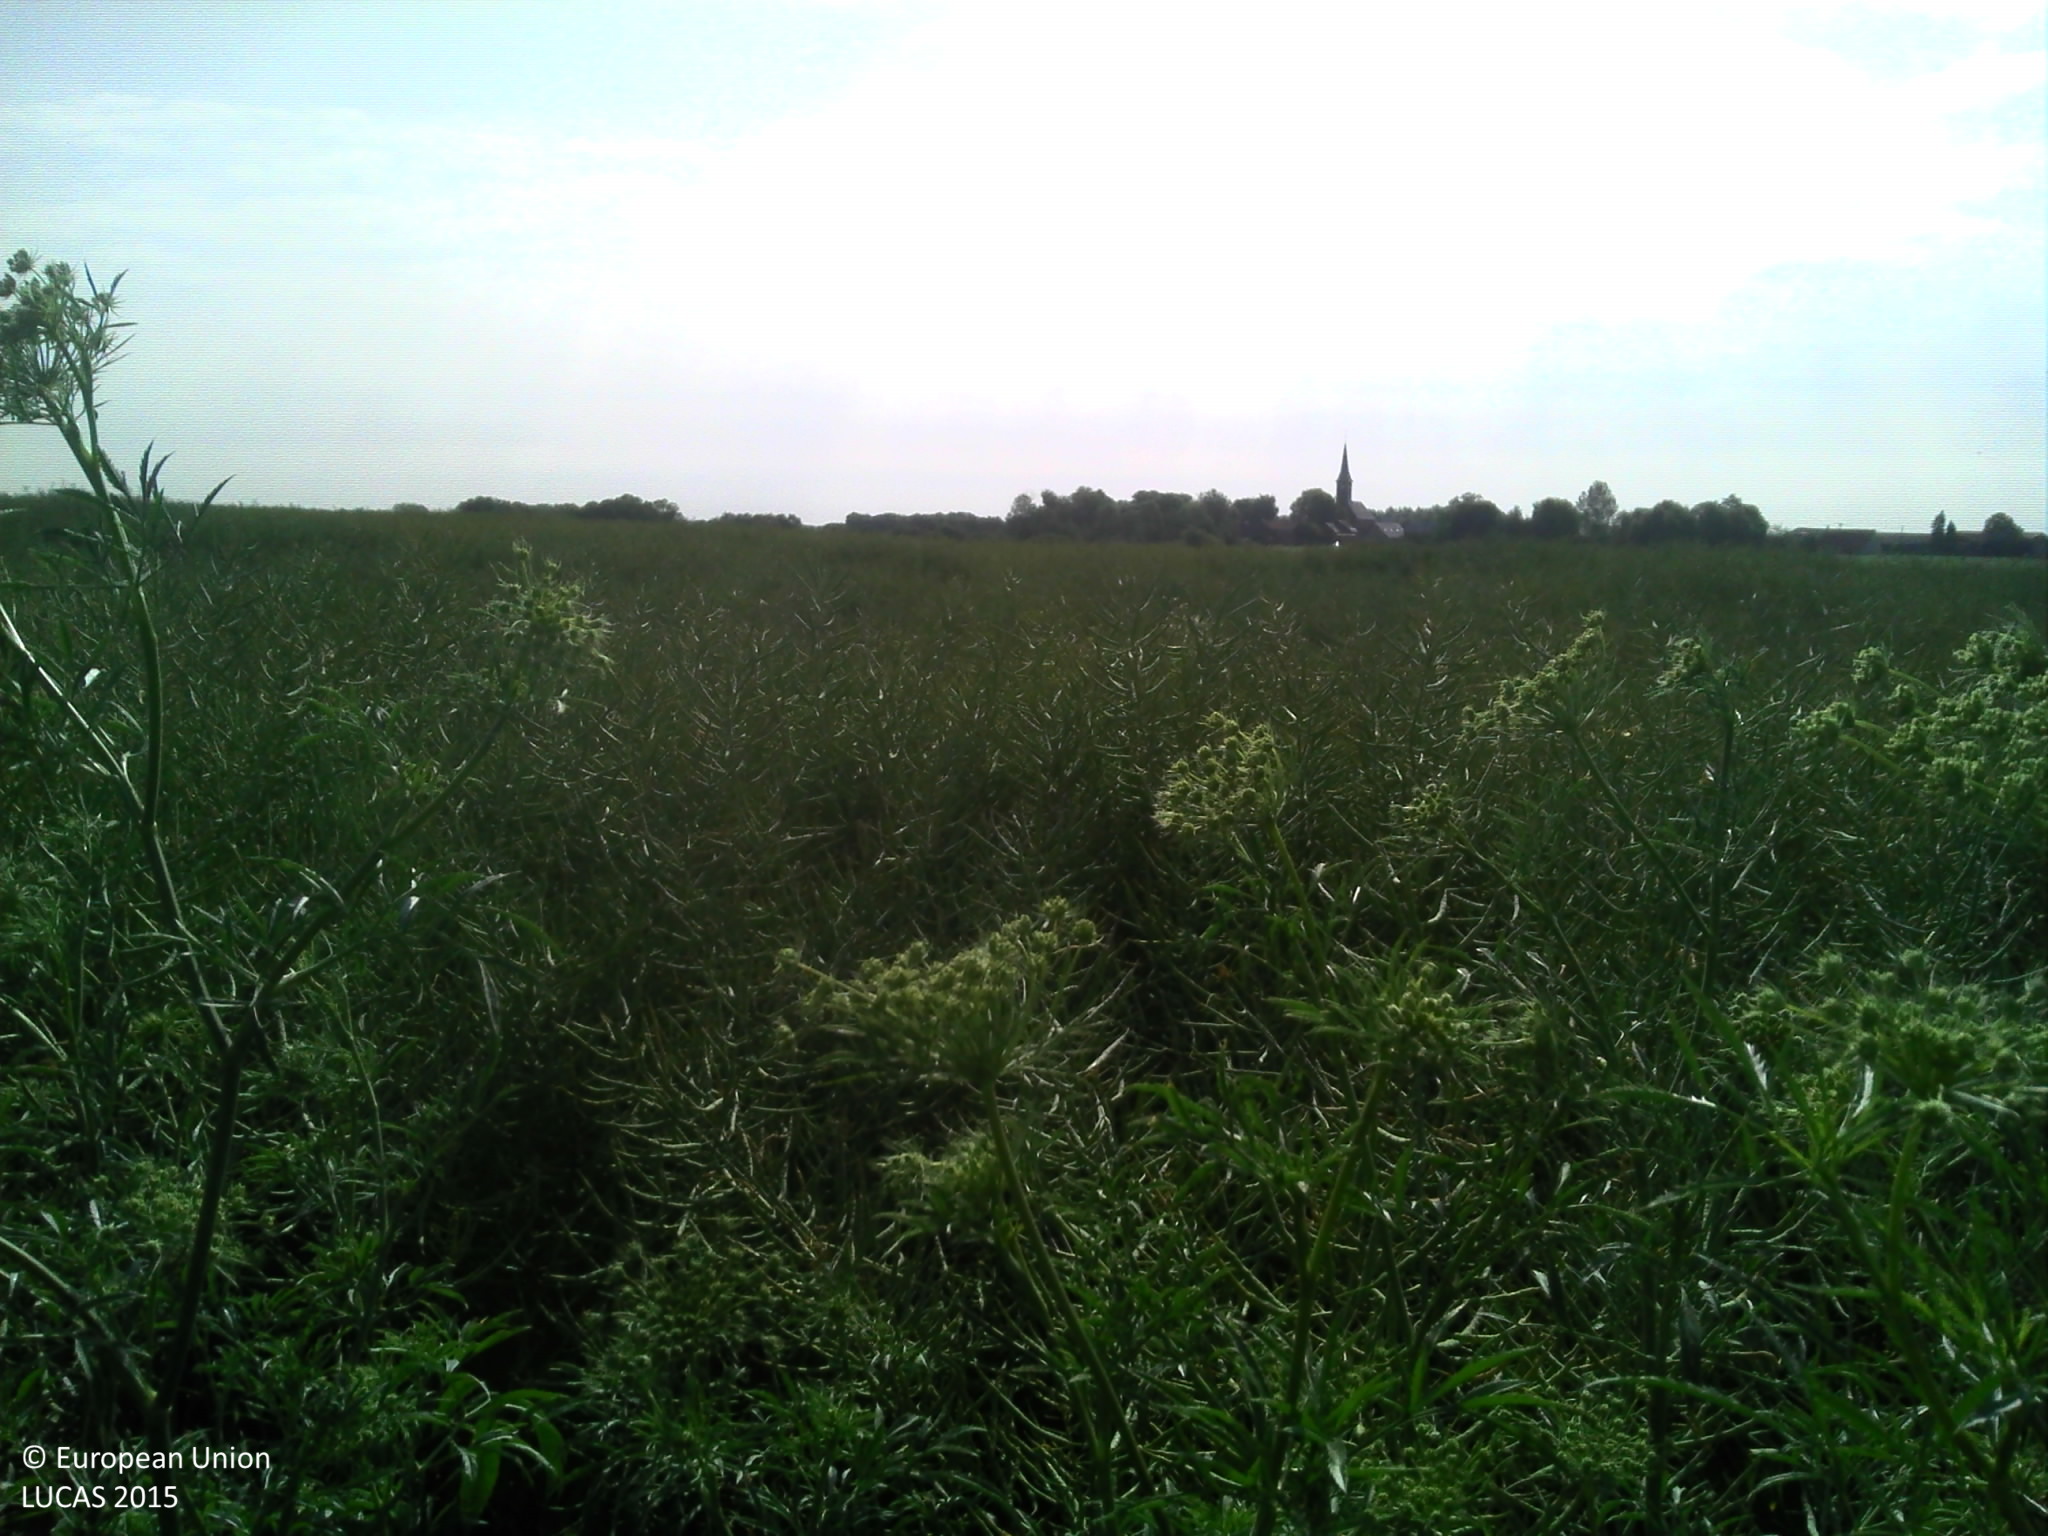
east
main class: Cropland
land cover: Common wheat
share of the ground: > 75 %
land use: Agriculture (excluding fallow land and kitchen gardens)
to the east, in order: Common wheat; Grass margins; Rape and turnip rape
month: June
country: FR
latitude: 49.7495
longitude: 2.3954
